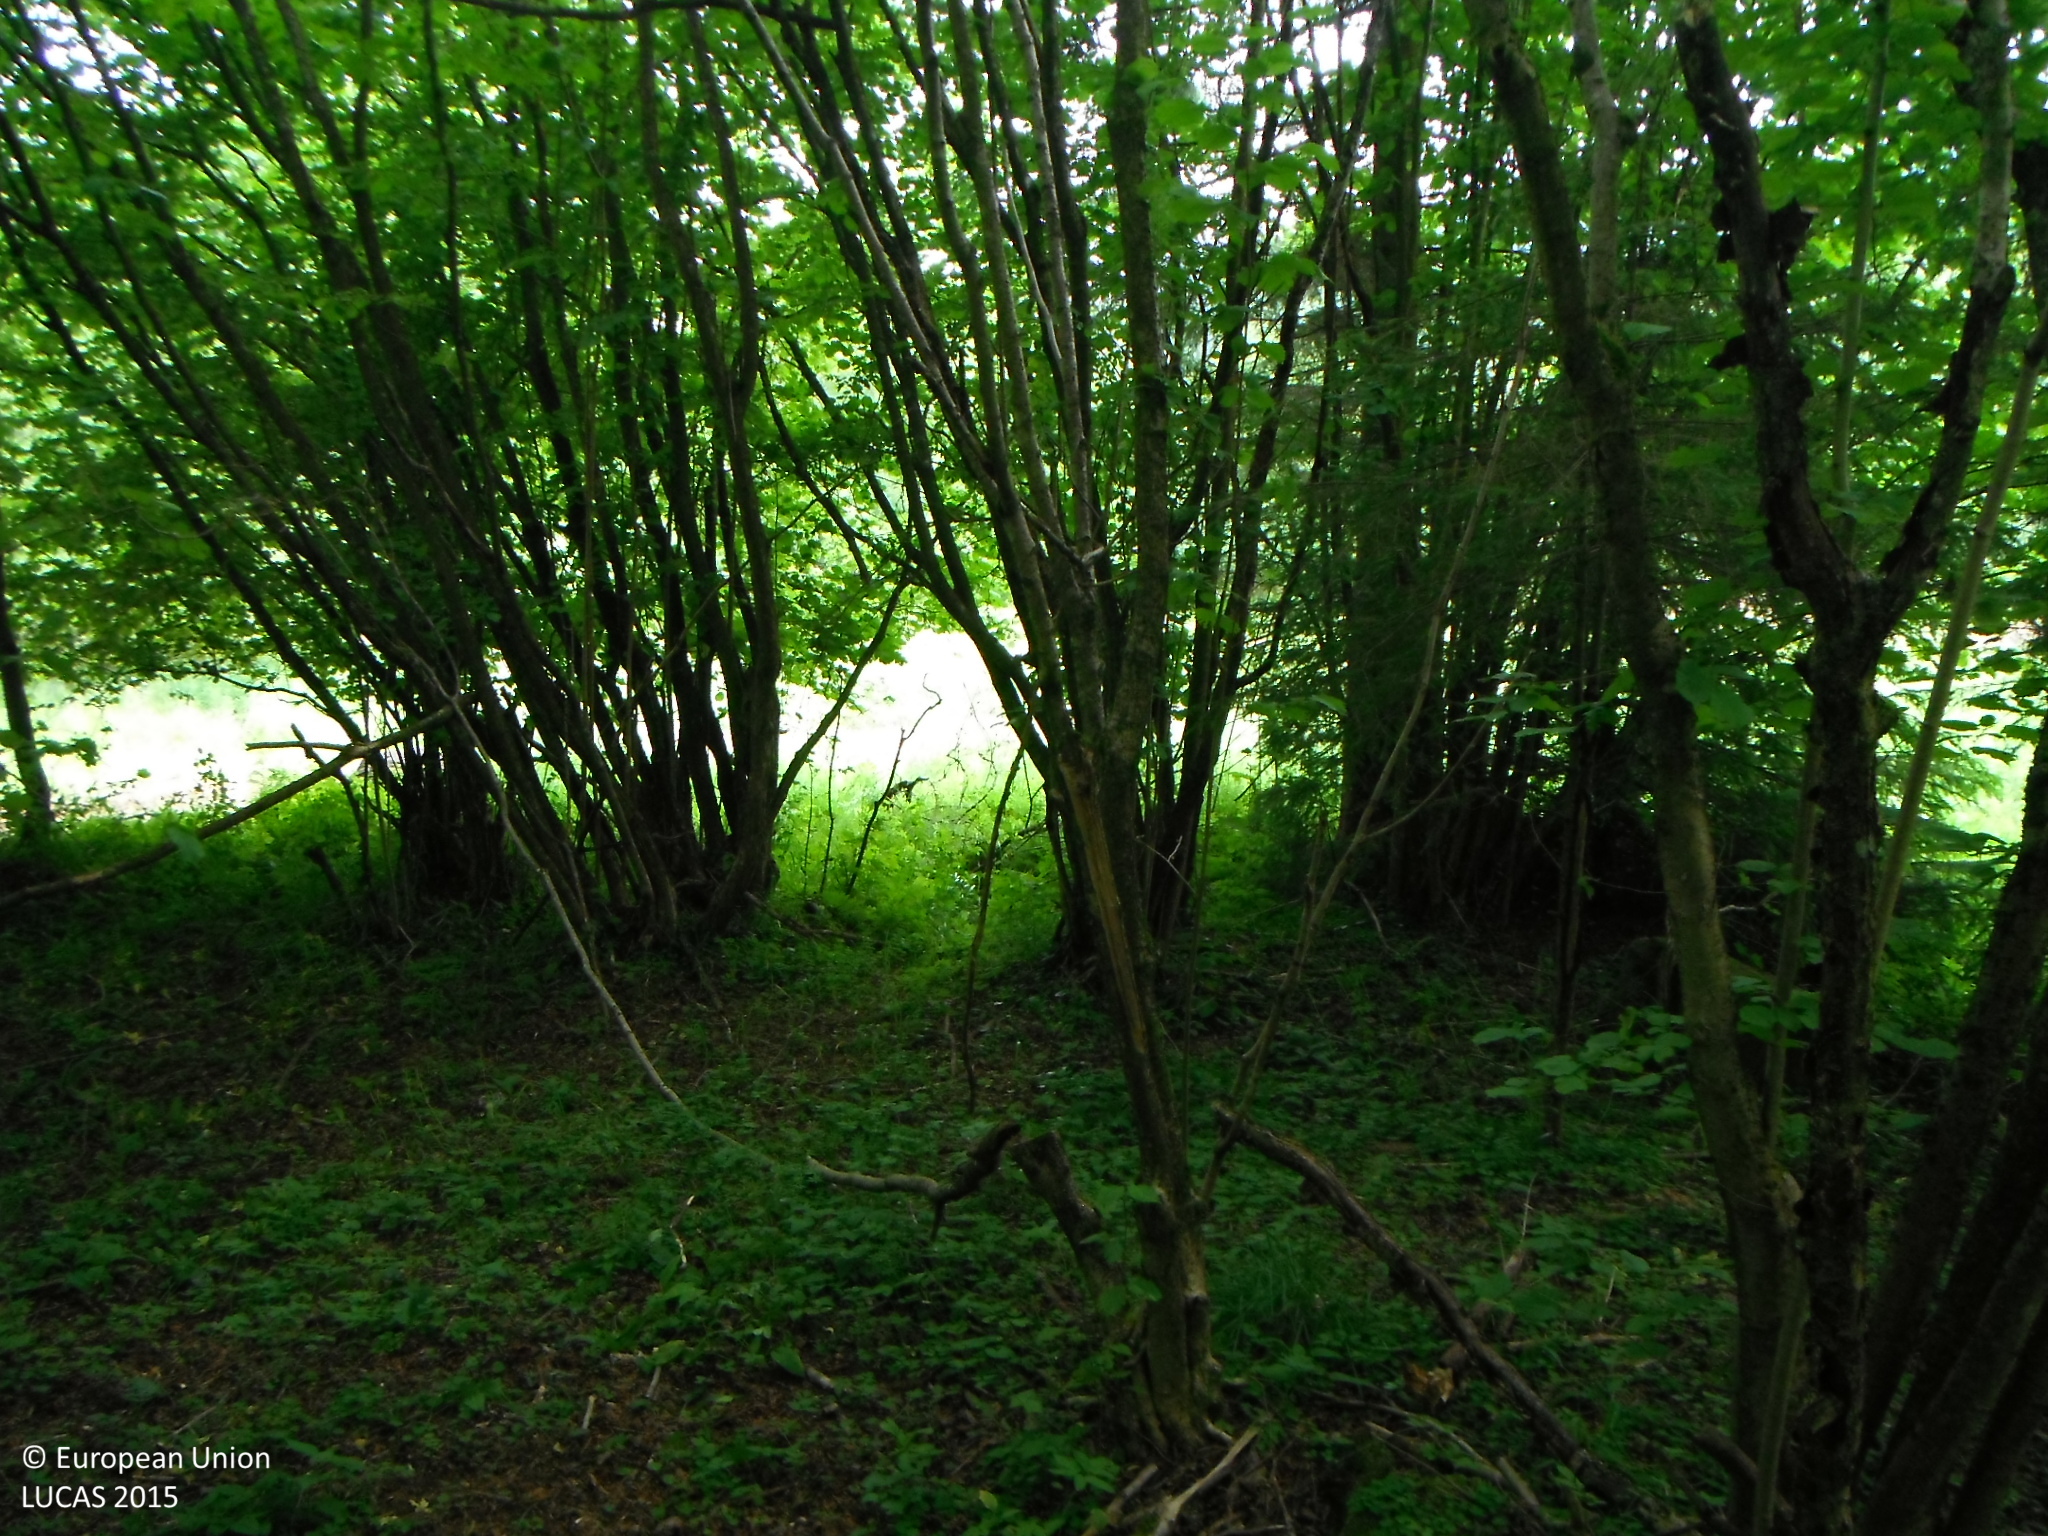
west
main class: Woodland
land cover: Spruce dominated mixed woodland
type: hemiboreal forest and nemoral coniferous forest and mixed broadleaved-coniferous forest
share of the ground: > 75 %
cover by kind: broadleaved forest trees 70 %, coniferous forest trees 30 %
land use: Forestry
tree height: > 5 m
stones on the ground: < 10 %
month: June
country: SK
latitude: 48.6516
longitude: 19.4316
